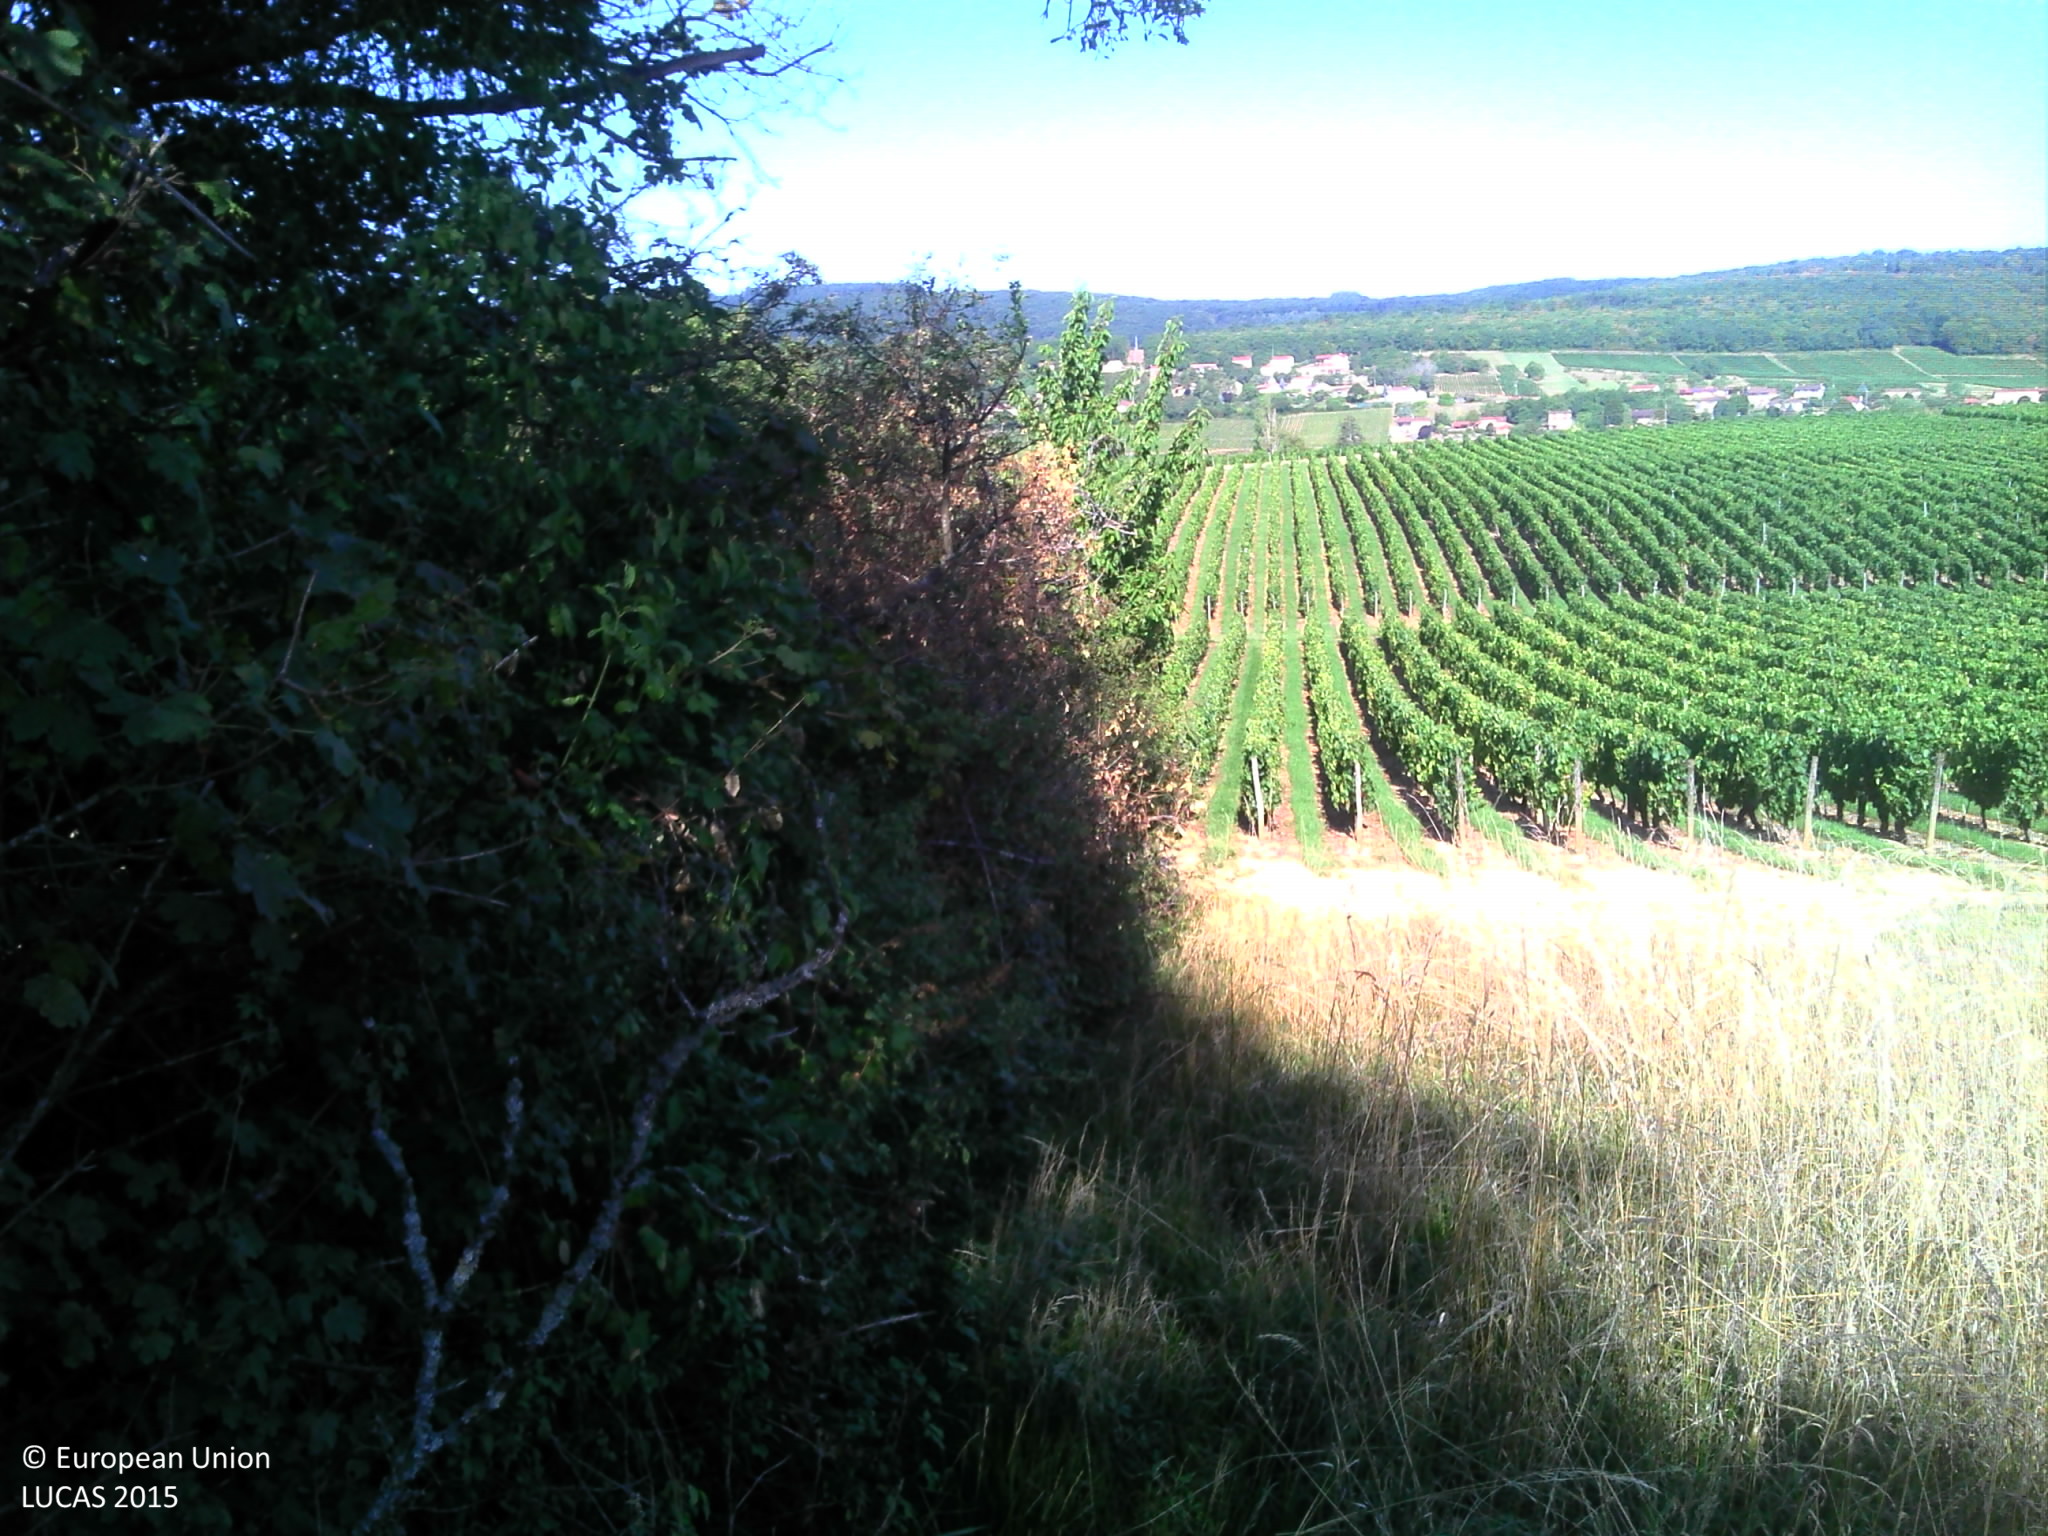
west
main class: Woodland
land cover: Broadleaved woodland
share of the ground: > 75 %
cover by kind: broadleaved forest trees 100 %
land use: Agriculture (excluding fallow land and kitchen gardens)
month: August
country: FR
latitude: 46.4584
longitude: 4.7807
